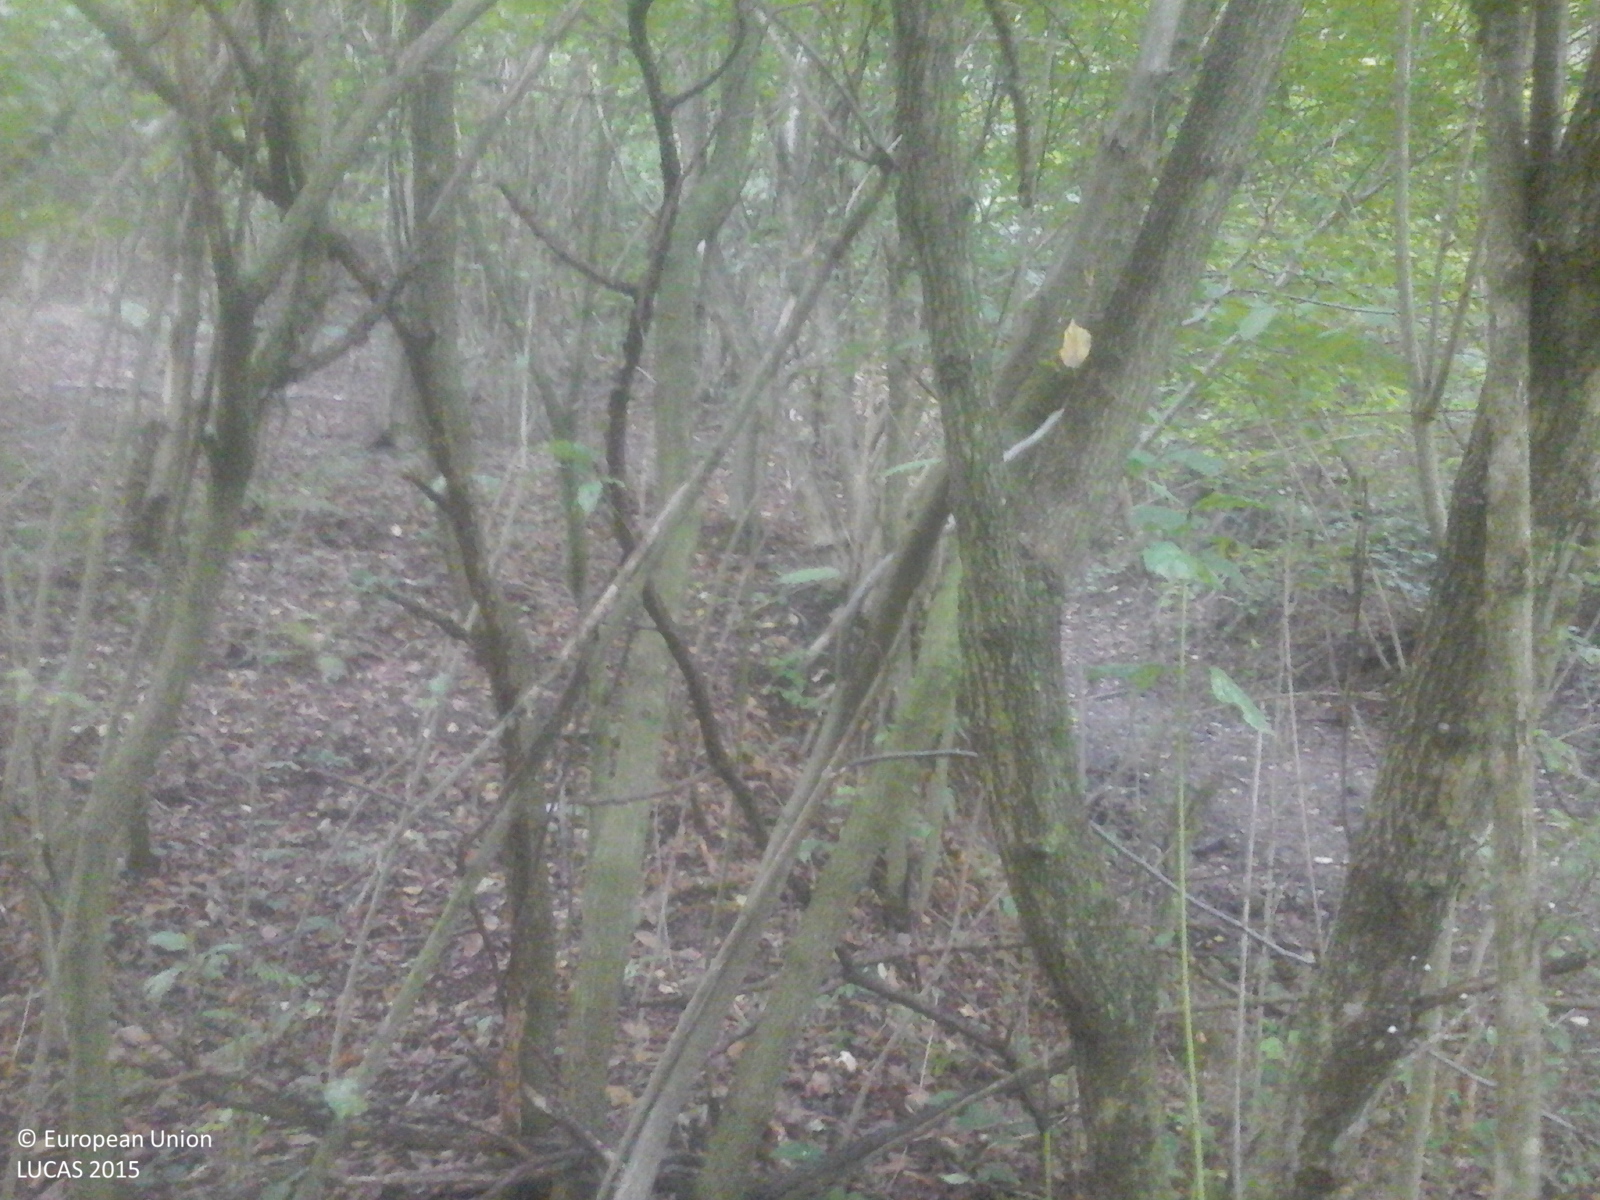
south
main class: Woodland
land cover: Broadleaved woodland
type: mesophytic deciduous forest
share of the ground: > 75 %
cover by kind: broadleaved forest trees 100 %
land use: Forestry
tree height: > 5 m
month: September
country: RO
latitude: 45.6502
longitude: 23.1055
